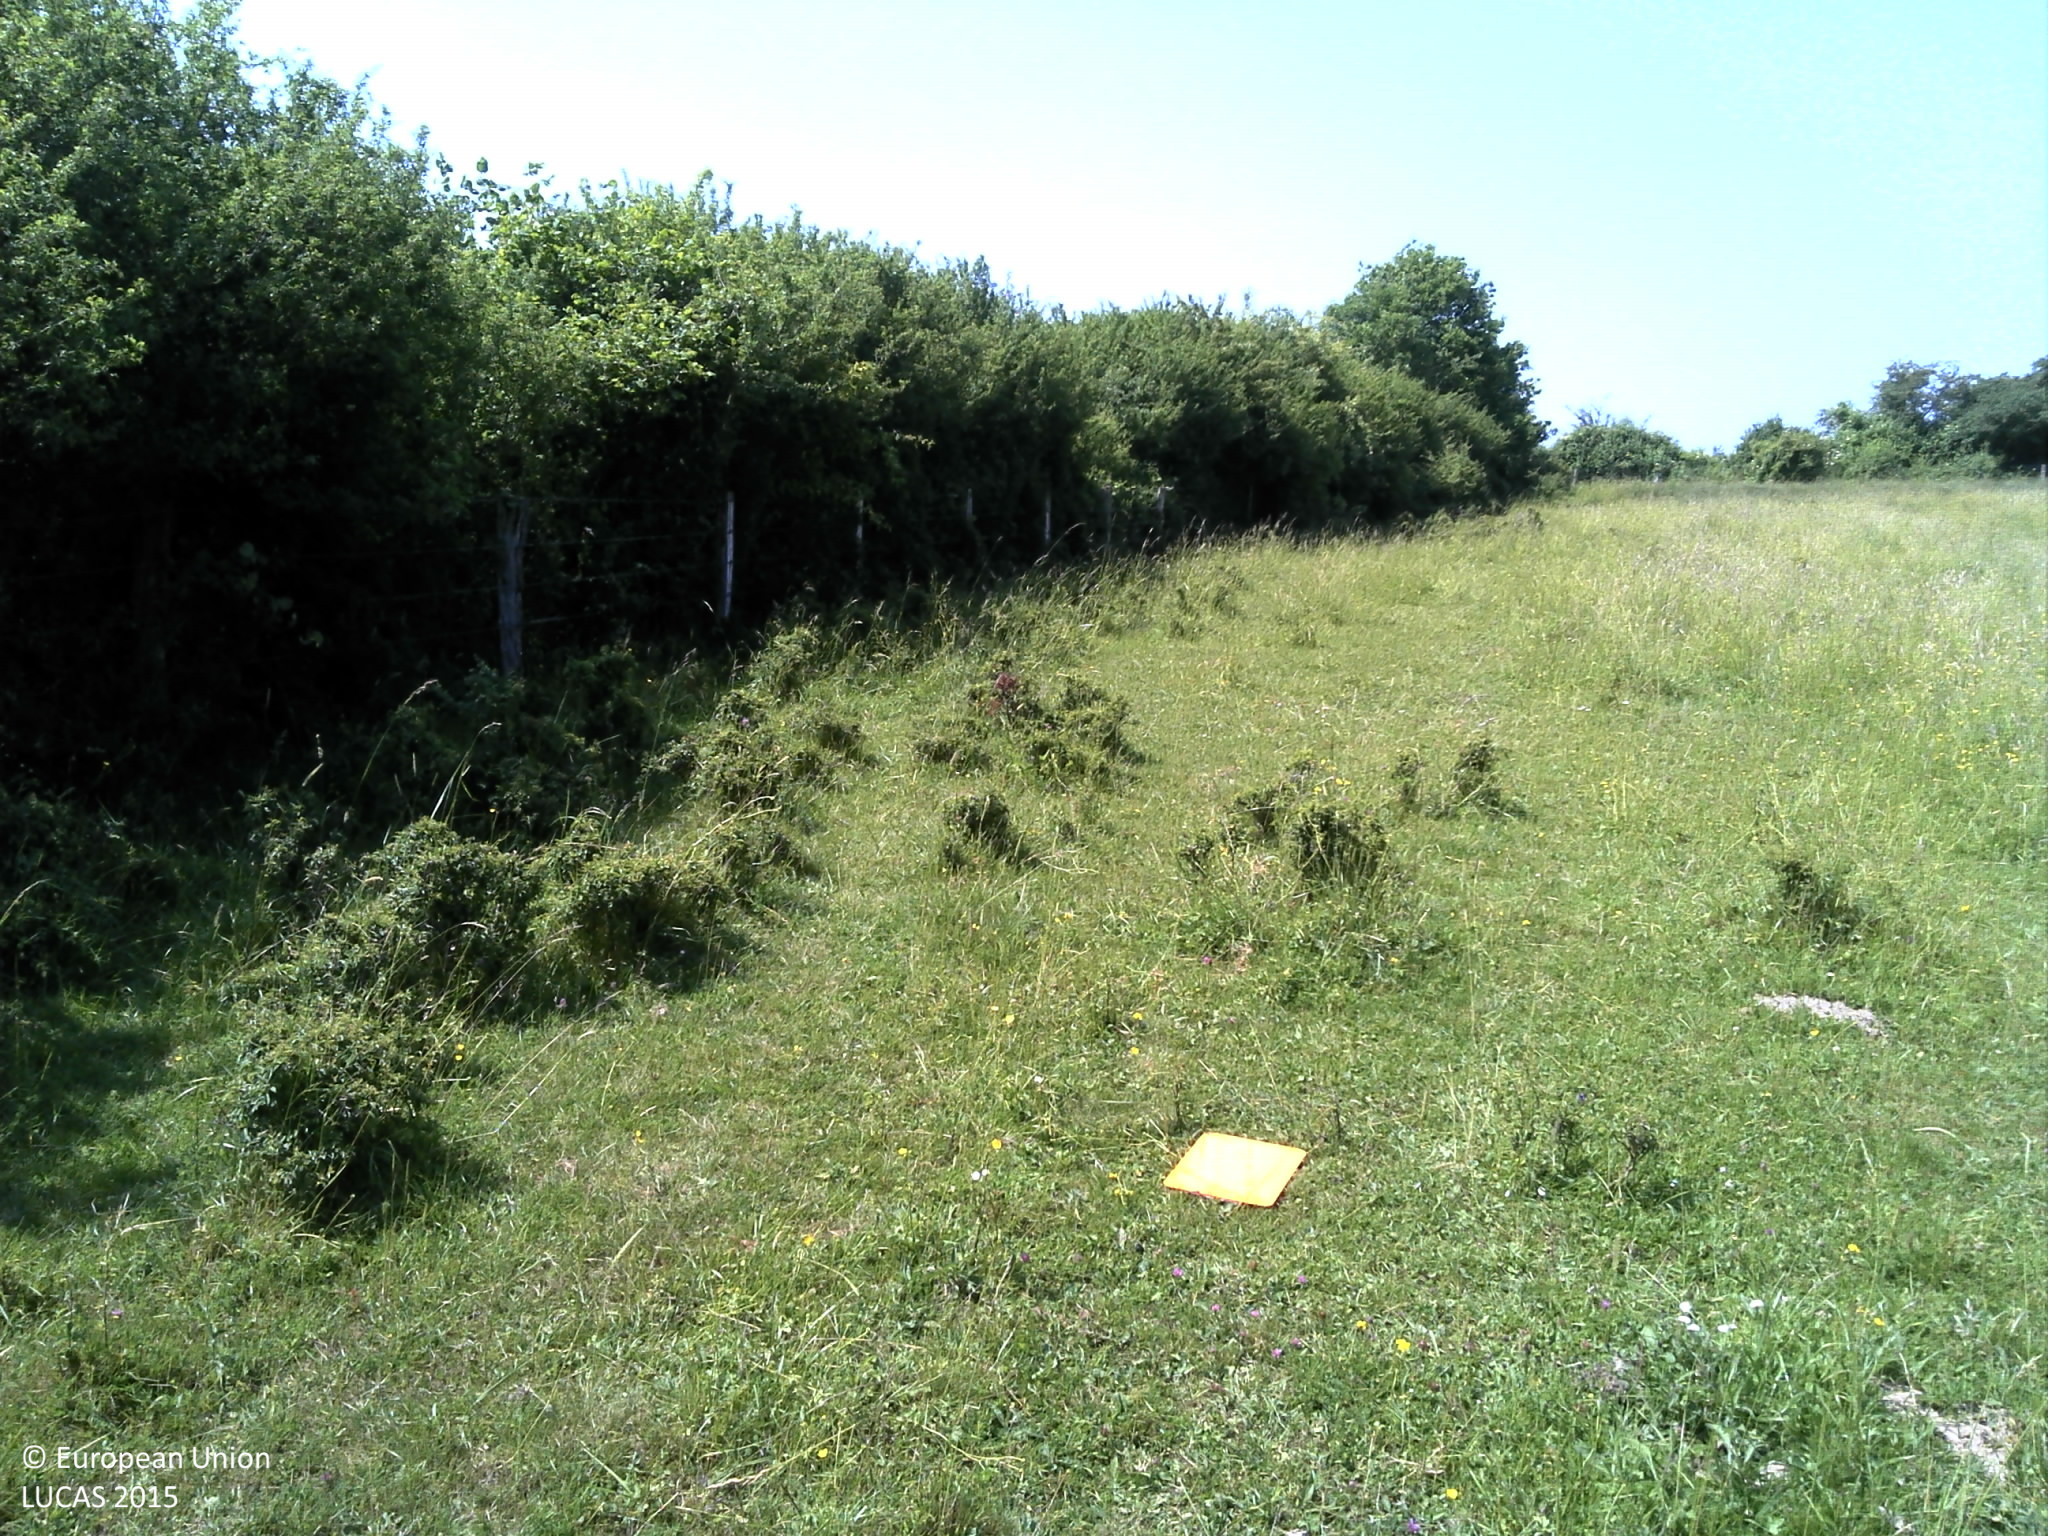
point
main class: Grassland
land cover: Grassland without tree/shrub cover
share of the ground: > 75 %
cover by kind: herbaceous plants 100 %
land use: Agriculture (excluding fallow land and kitchen gardens)
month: June
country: FR
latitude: 49.0590
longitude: 6.2090
